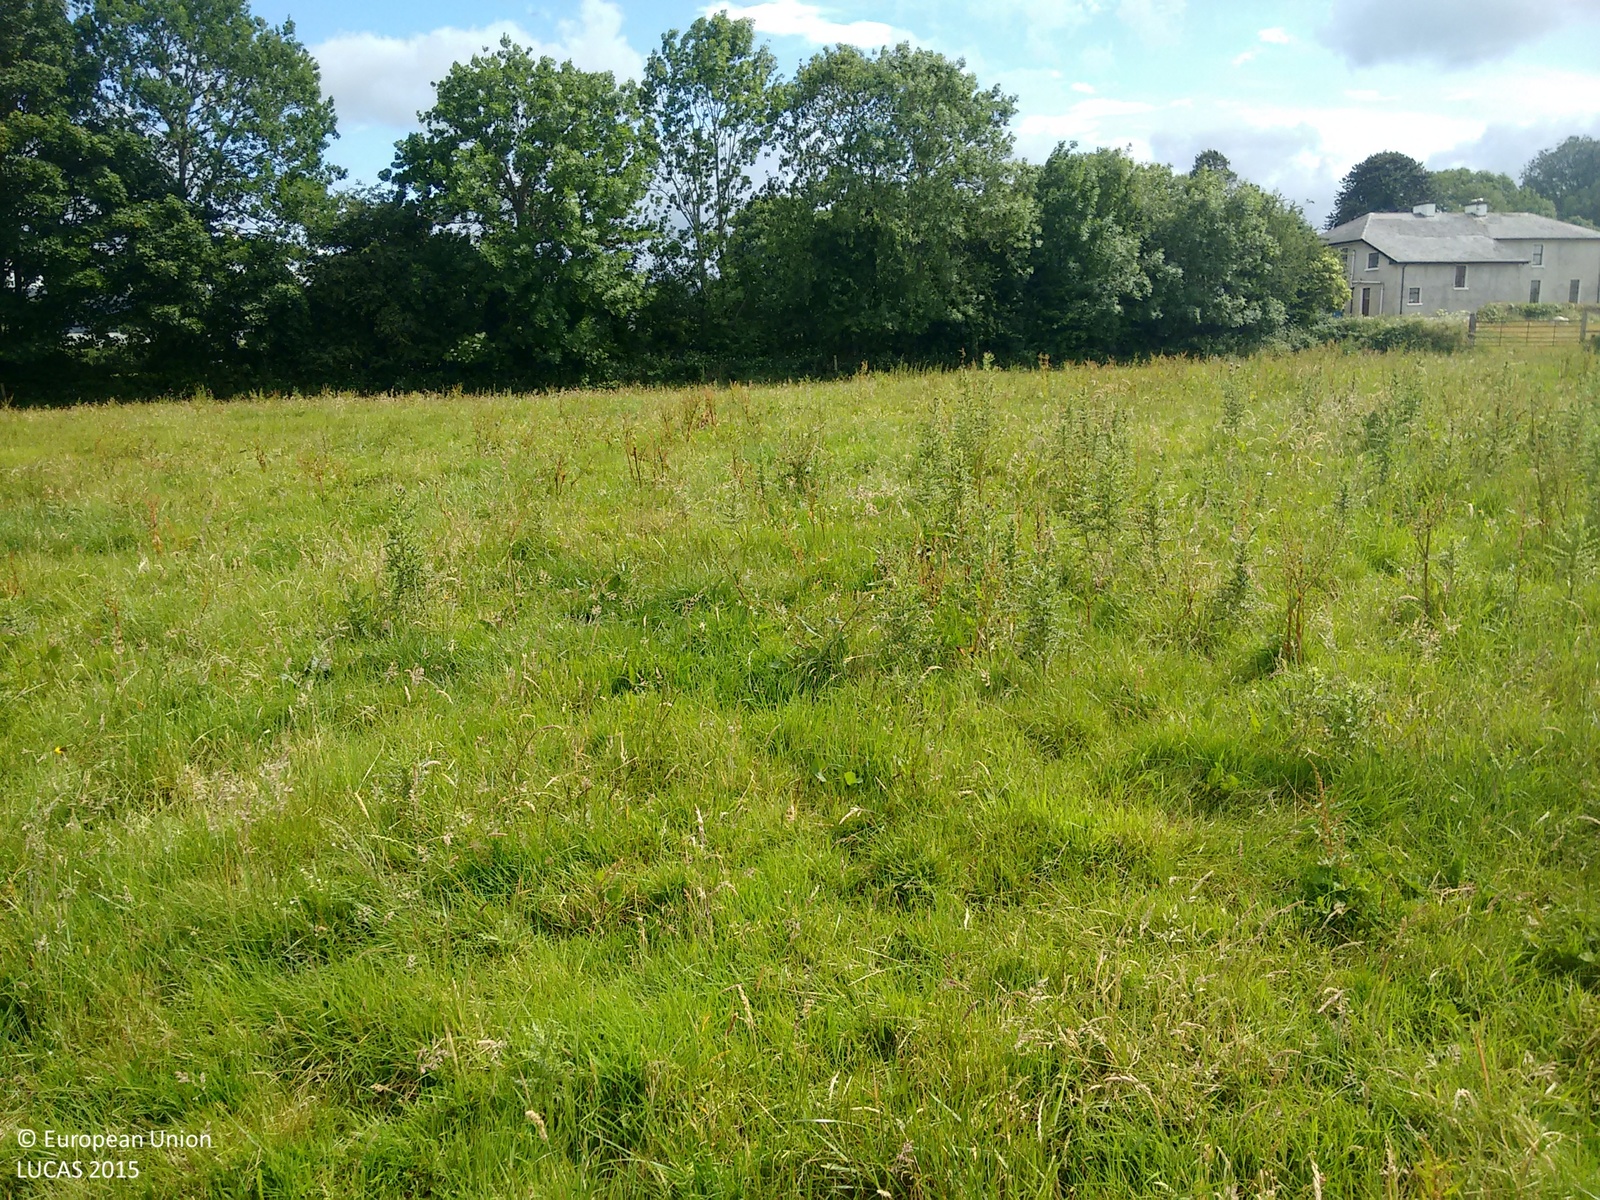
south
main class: Grassland
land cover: Grassland without tree/shrub cover
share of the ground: > 75 %
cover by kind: herbaceous plants 100 %
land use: Agriculture (excluding fallow land and kitchen gardens)
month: July
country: IE
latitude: 52.1340
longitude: -8.8946
